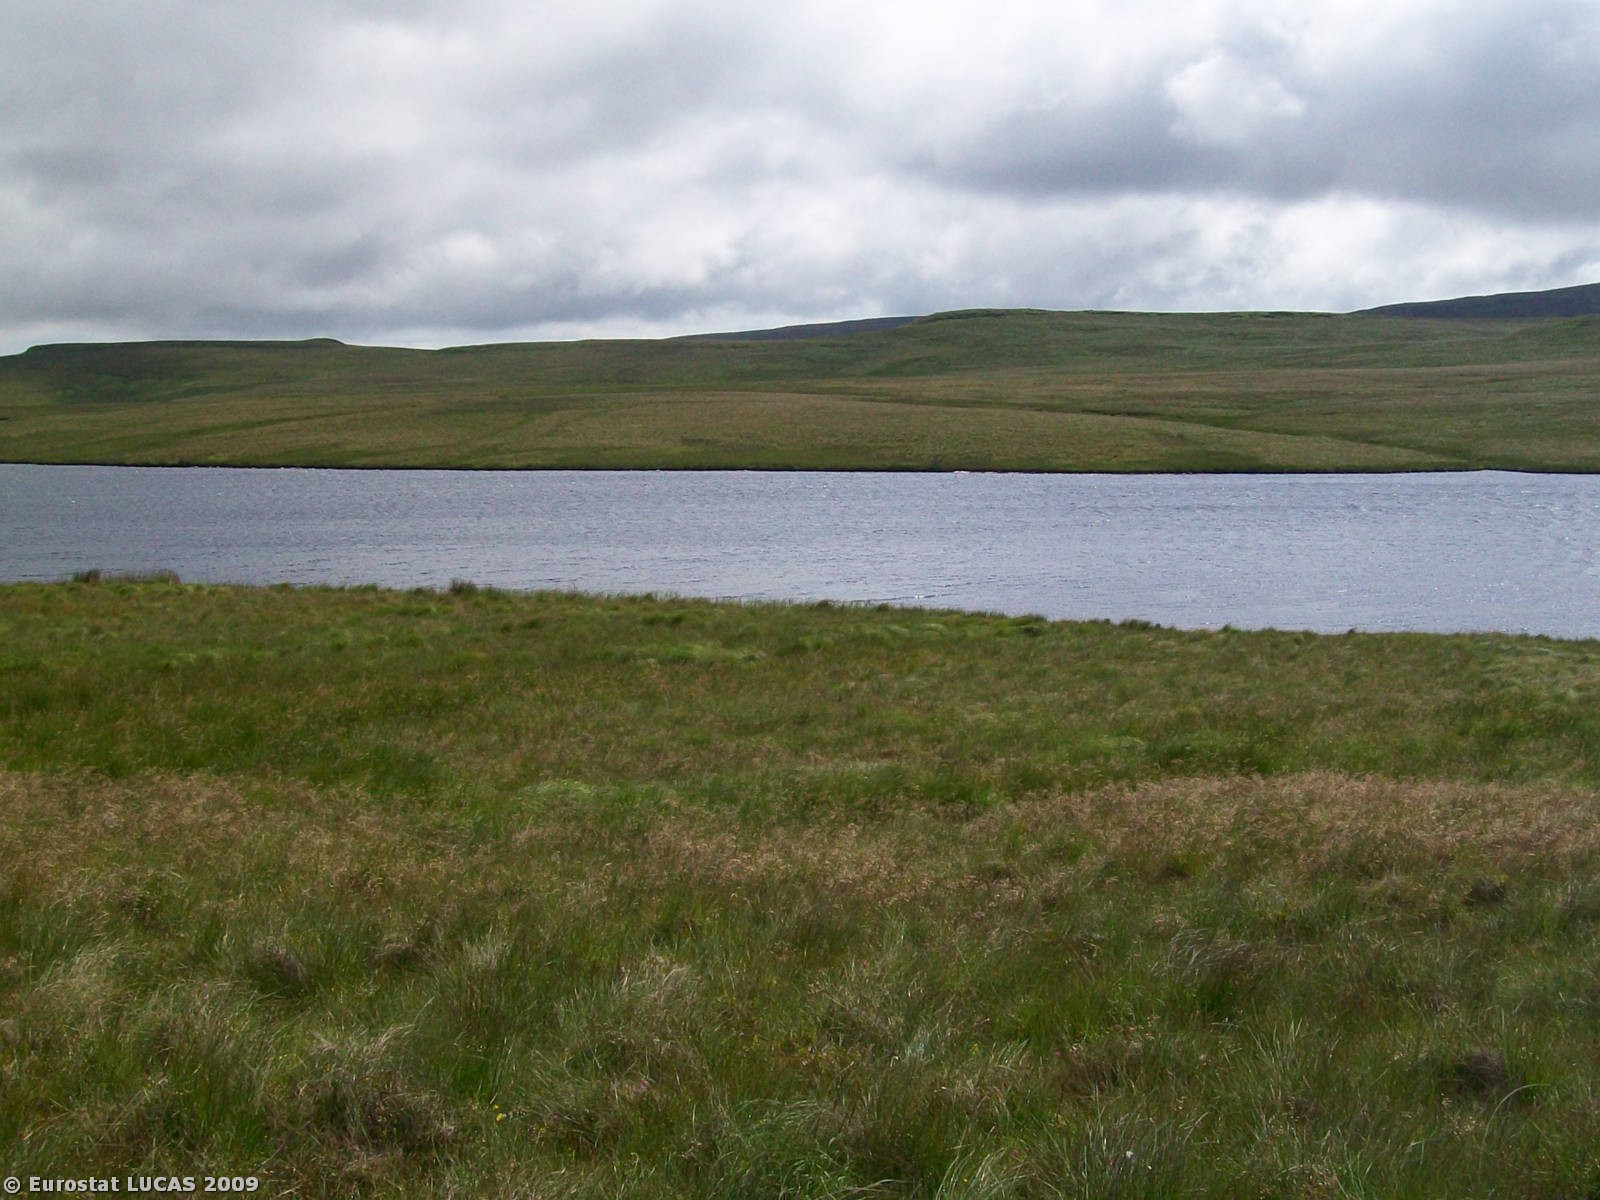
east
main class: Wetlands
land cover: Peatbogs
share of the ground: > 75 %
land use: Nature reserves
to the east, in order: Peatbogs; Inland water bodies
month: July
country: GB
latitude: 54.9913
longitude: -6.1324
